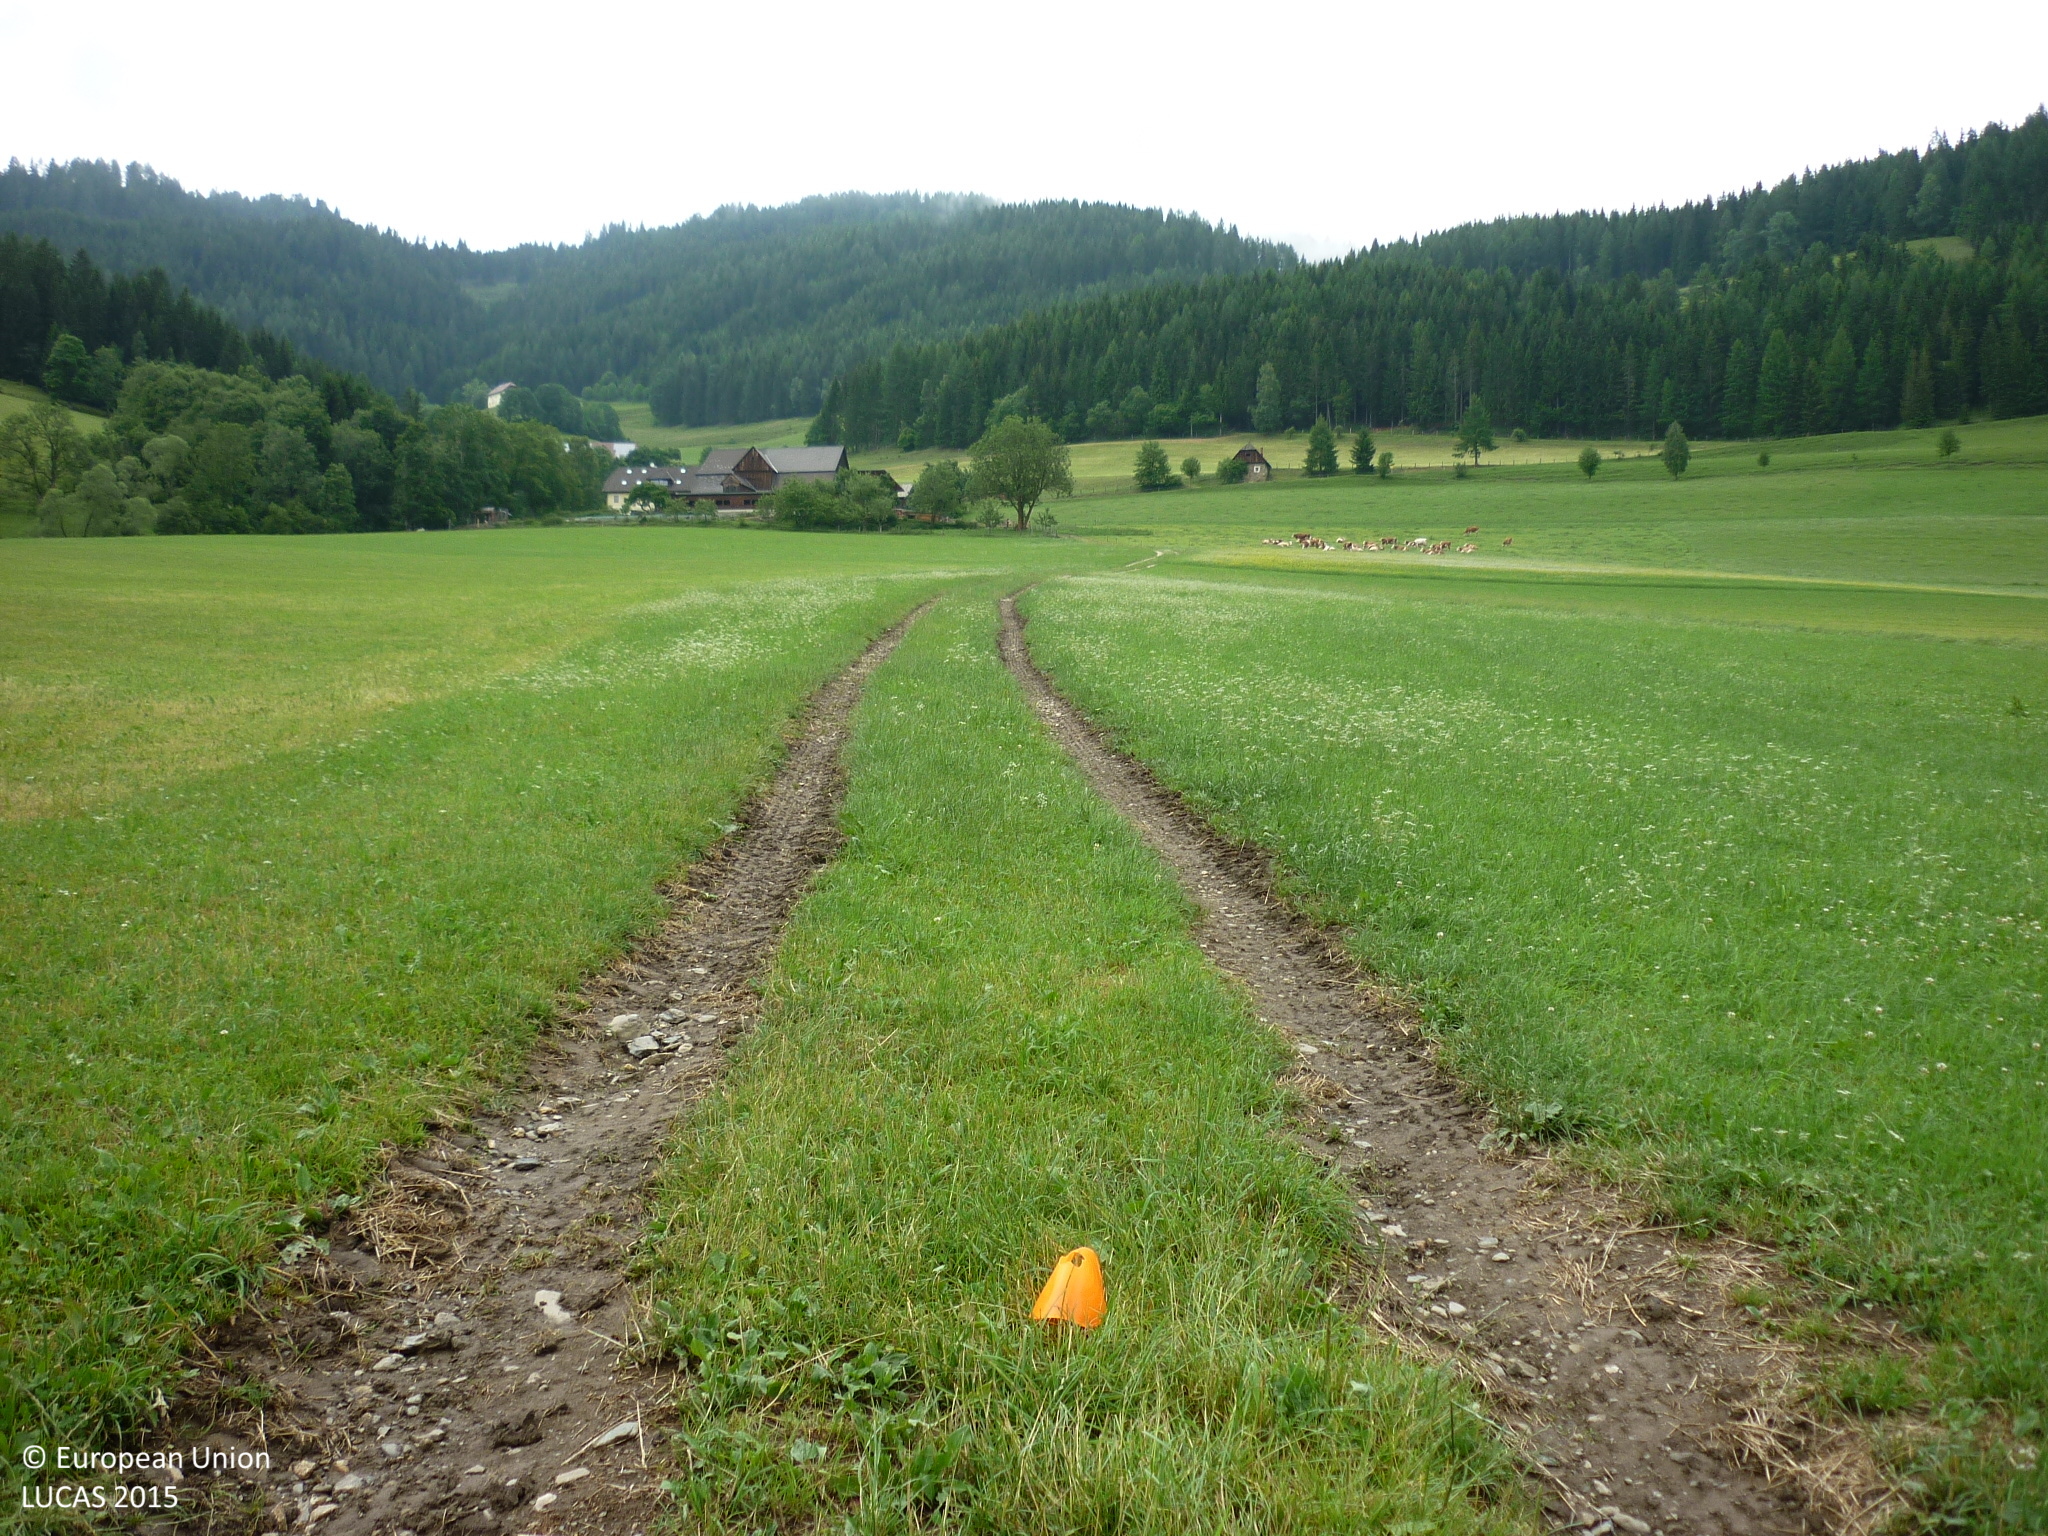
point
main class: Grassland
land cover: Grassland without tree/shrub cover
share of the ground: > 75 %
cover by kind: herbaceous plants 100 %
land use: Agriculture (excluding fallow land and kitchen gardens)
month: June
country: AT
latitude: 47.0940
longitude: 14.3063
